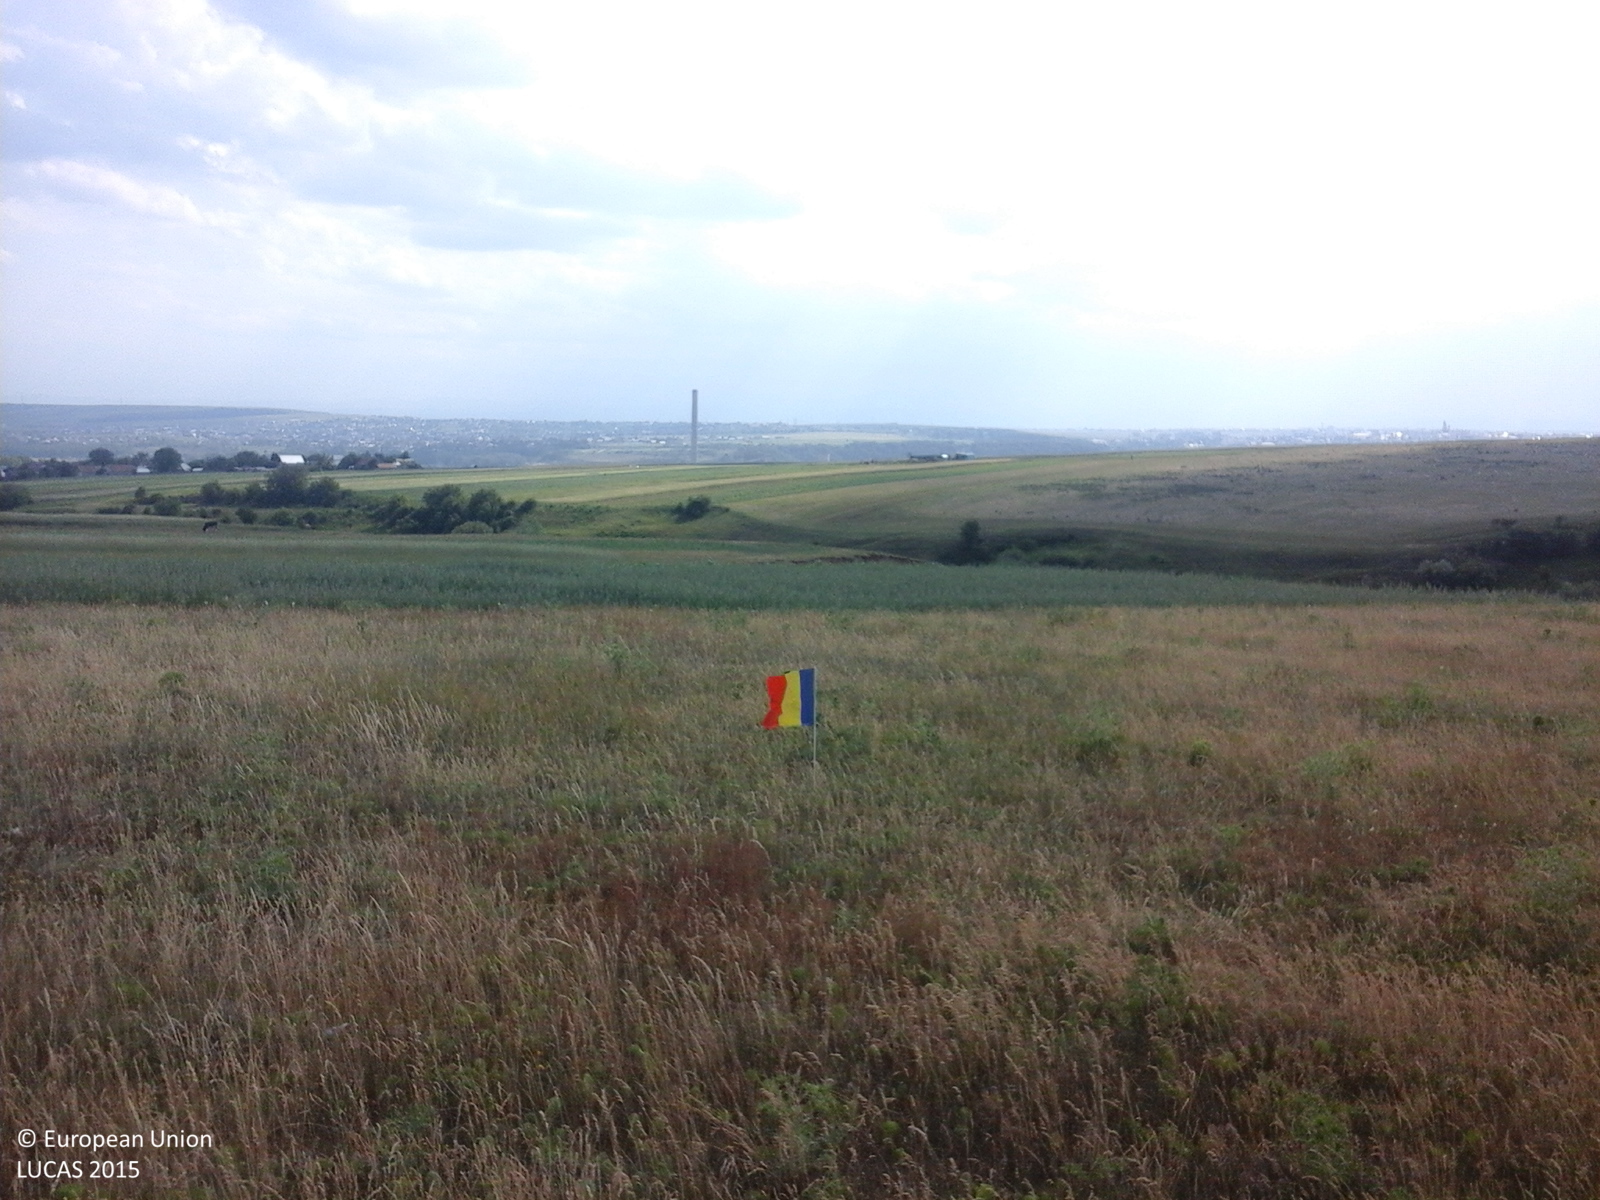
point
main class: Grassland
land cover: Grassland without tree/shrub cover
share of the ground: > 75 %
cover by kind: herbaceous plants 100 %
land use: Agriculture (excluding fallow land and kitchen gardens)
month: June
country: RO
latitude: 47.6754
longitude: 26.3216
